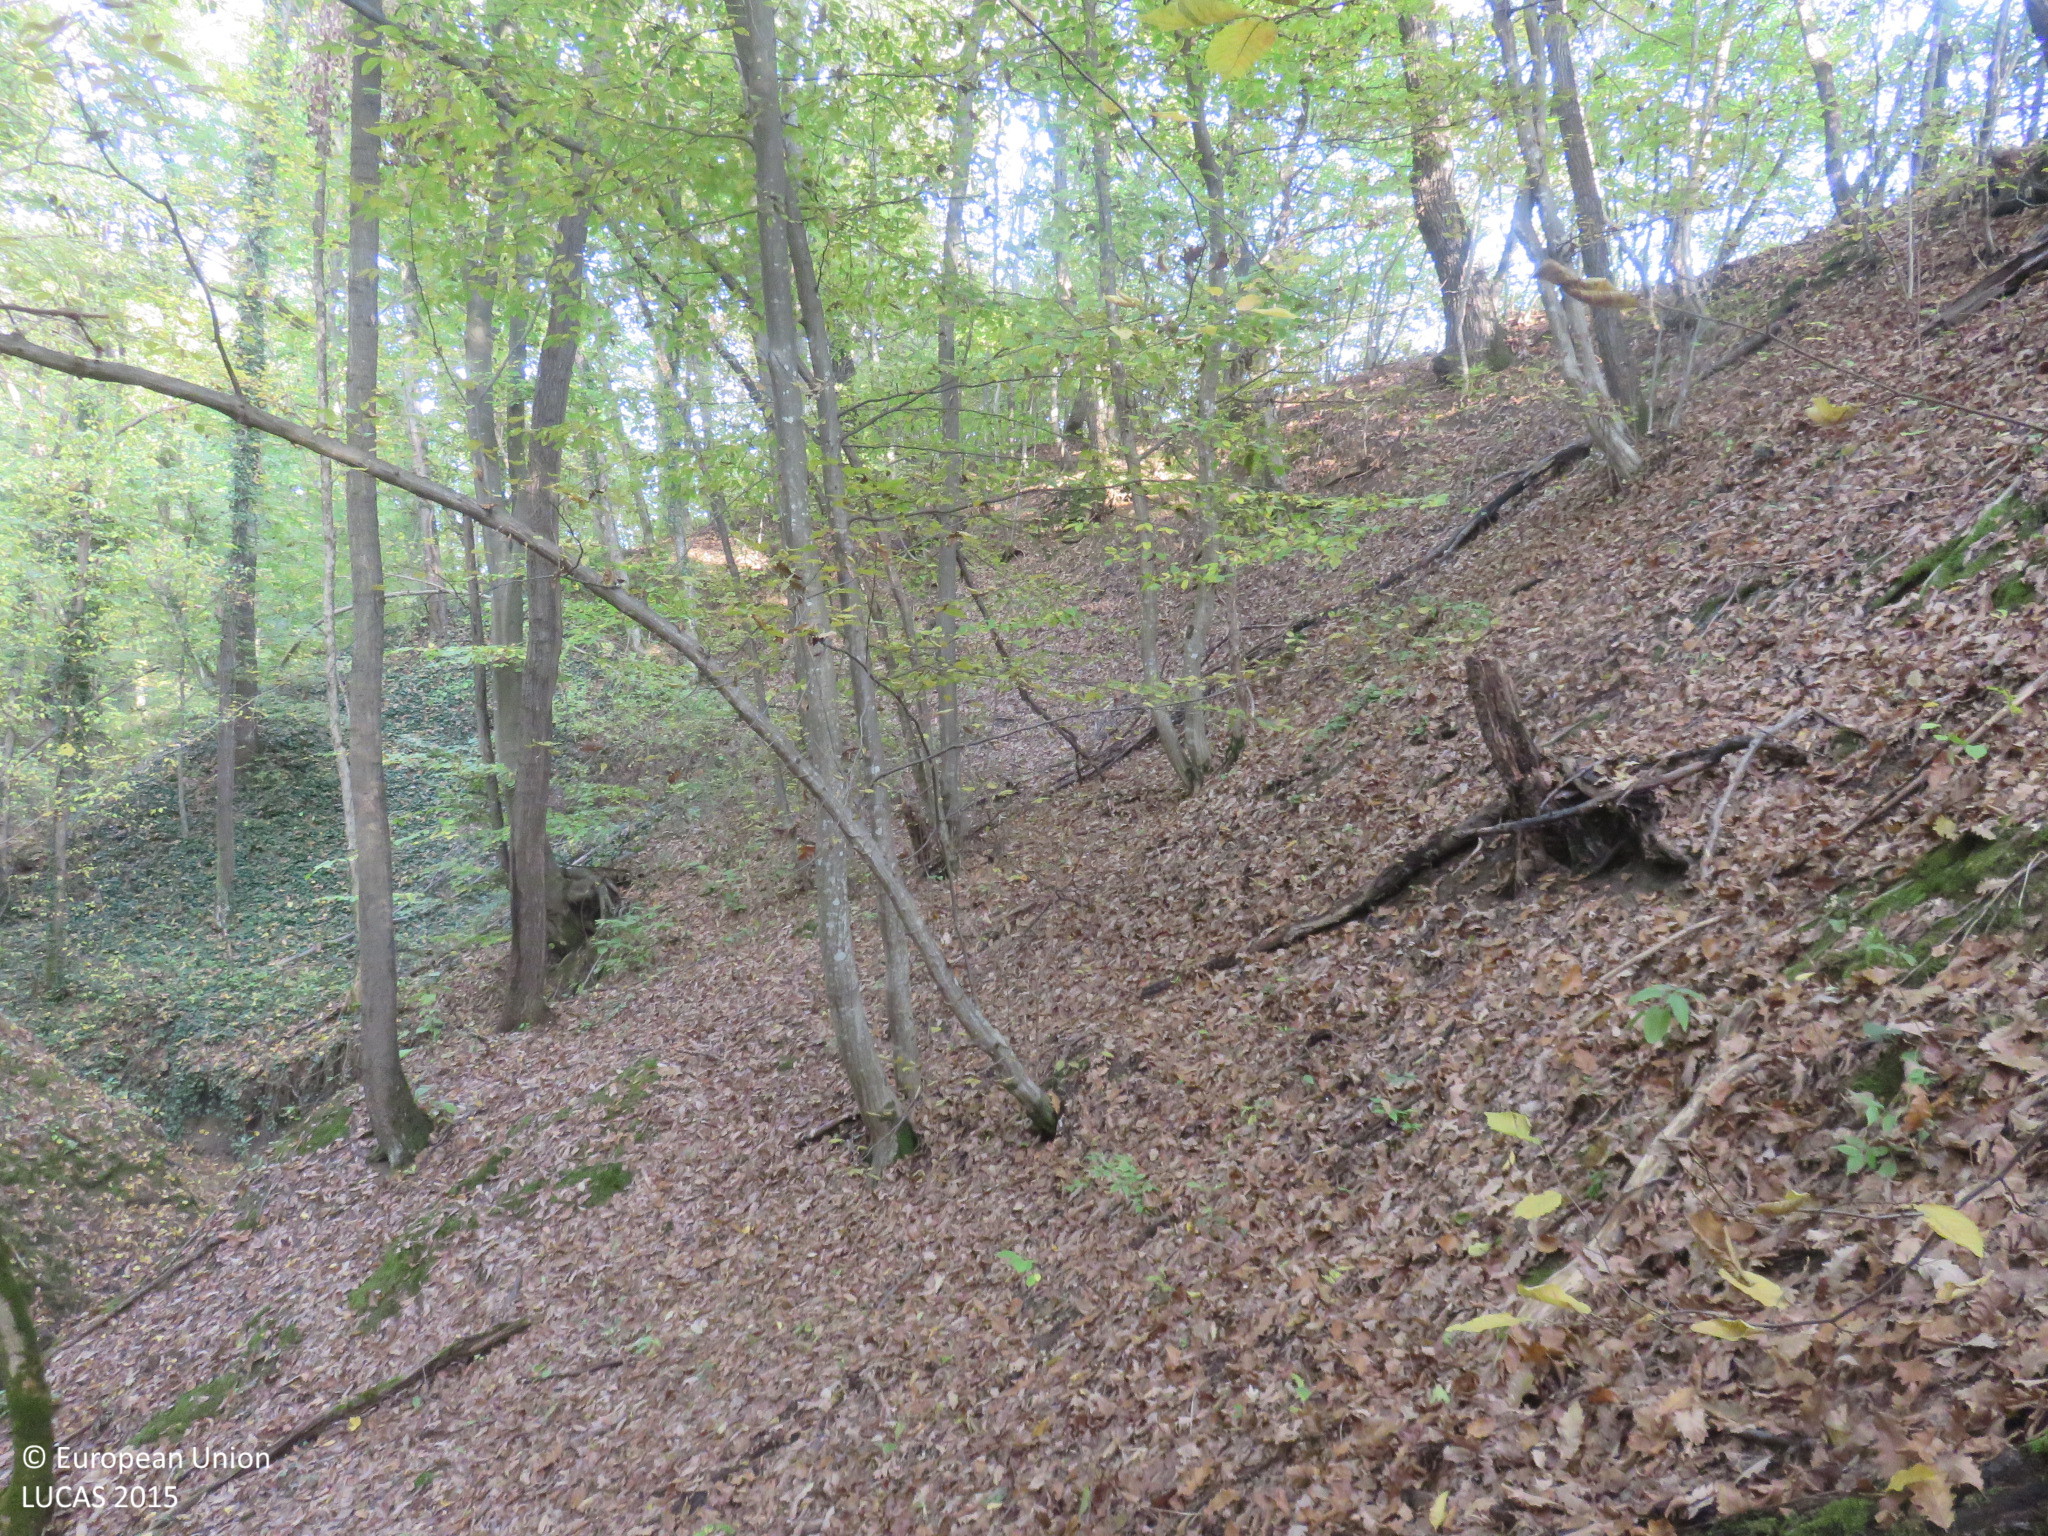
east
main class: Woodland
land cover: Broadleaved woodland
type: beech forest
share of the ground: > 75 %
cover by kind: broadleaved forest trees 90 %, unconsolidated bare surface 10 %
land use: Forestry
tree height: > 5 m
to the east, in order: Broadleaved woodland; Shrubland without tree cover; Grassland with sparse tree/shrub cover; Other fruit trees and berries
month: October
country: BG
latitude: 42.9763
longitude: 24.7632
